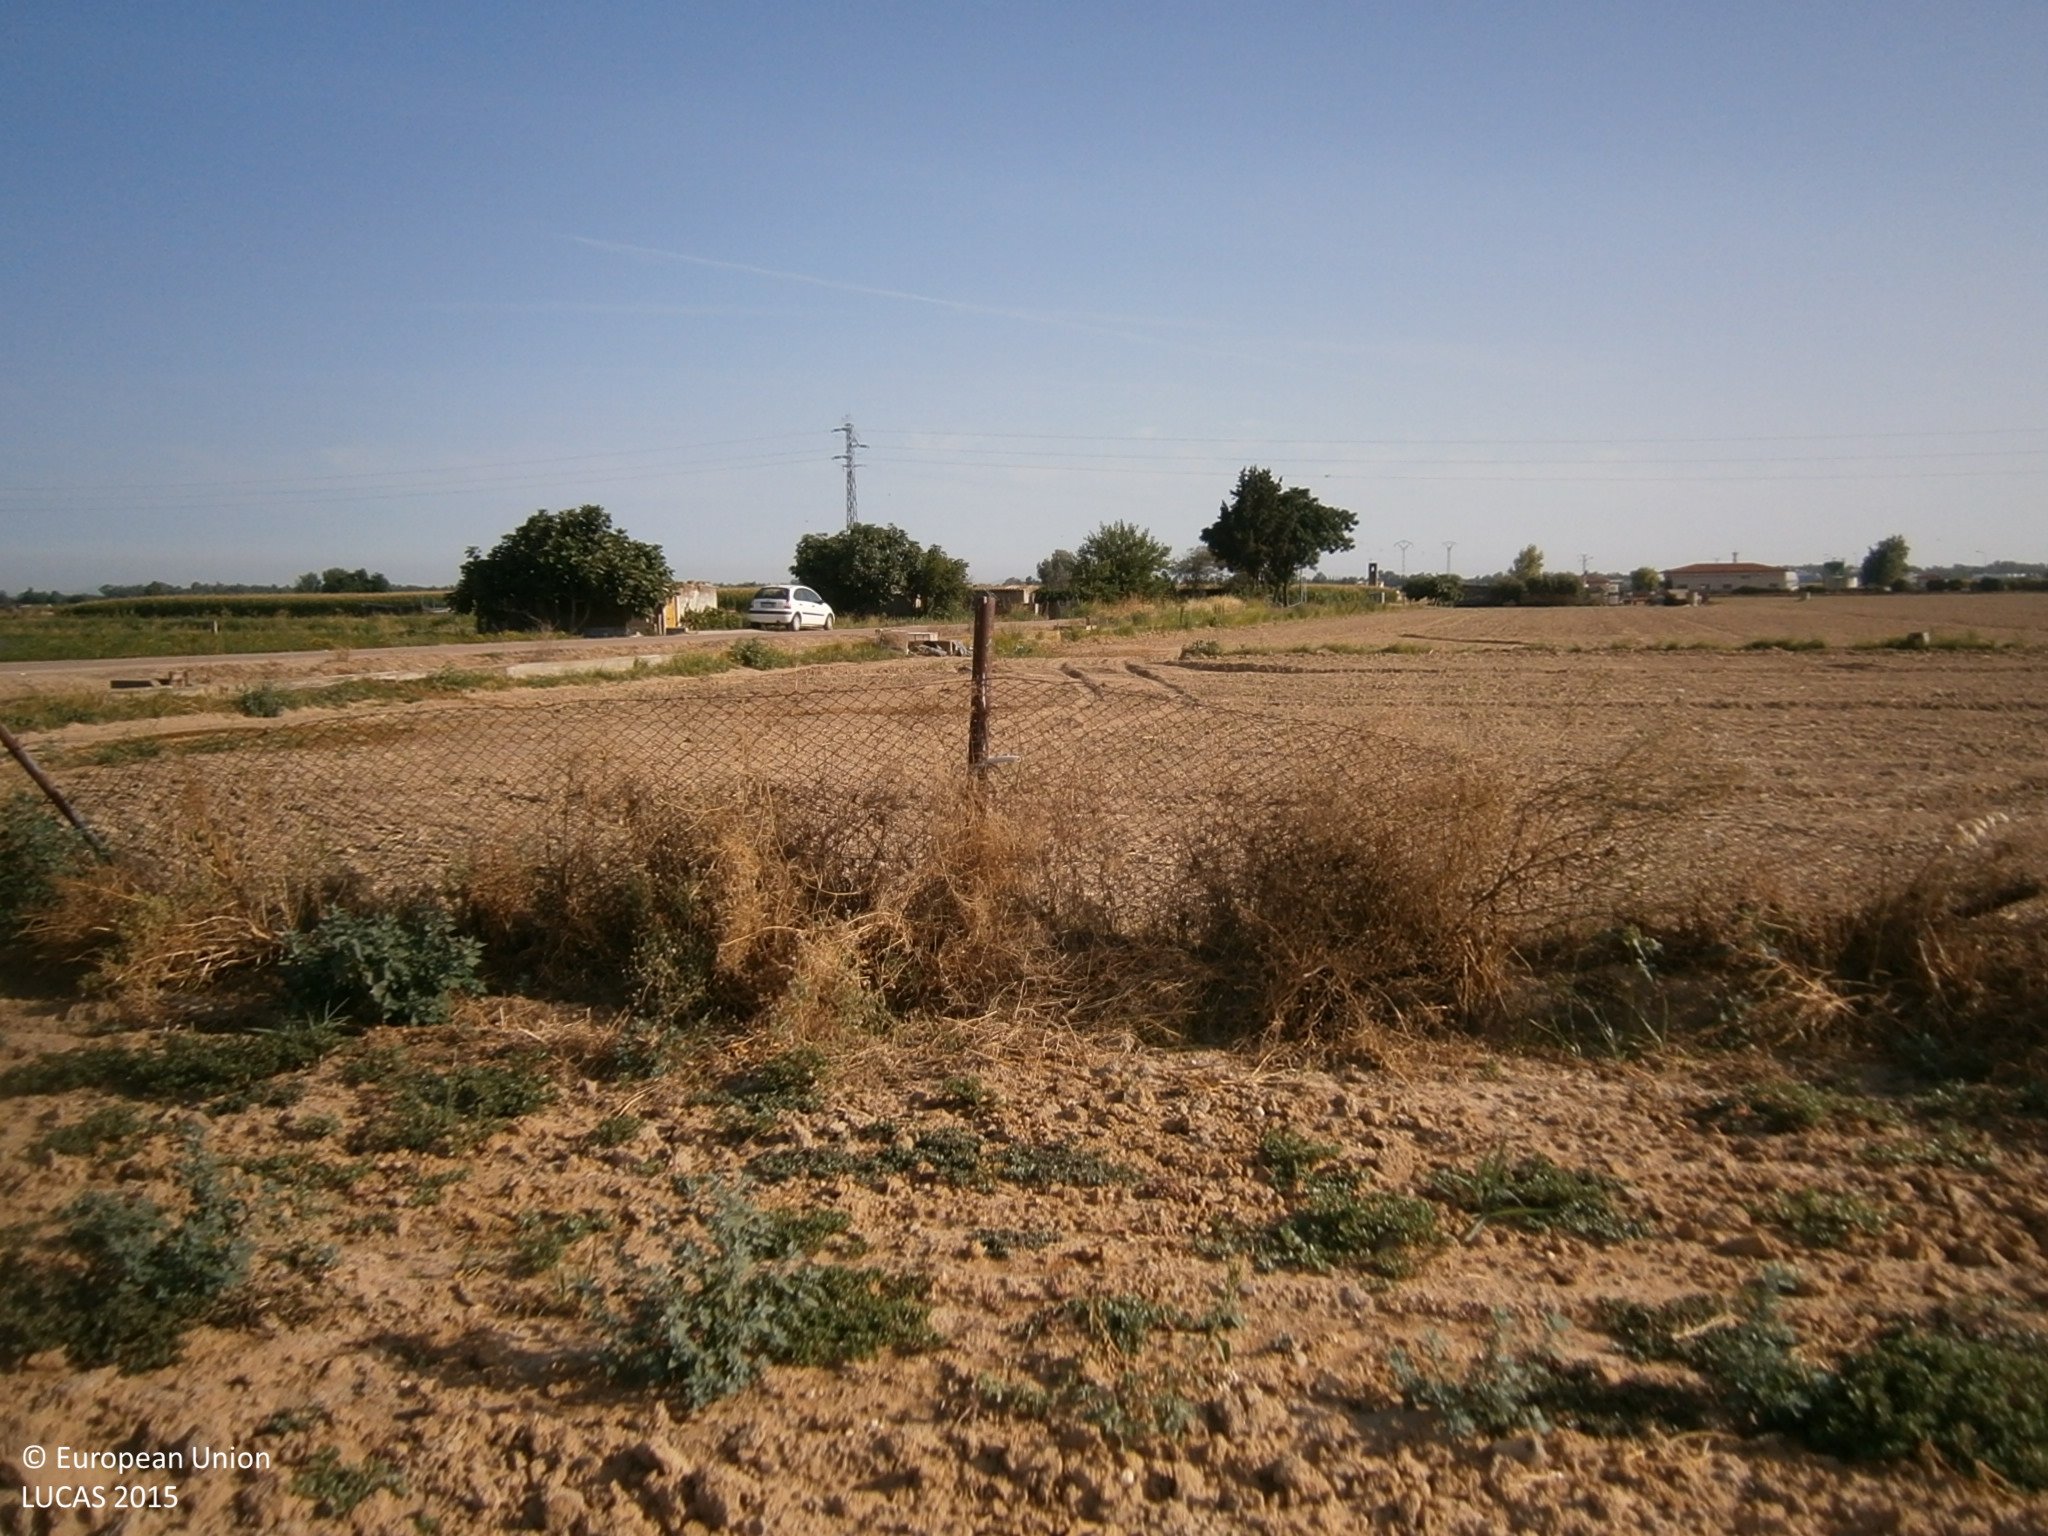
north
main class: Grassland
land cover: Spontaneously vegetated surfaces
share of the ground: > 75 %
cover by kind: unconsolidated bare surface 90 %, herbaceous plants 10 %
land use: Fallow land
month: July
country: ES
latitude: 38.8877
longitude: -6.8647
